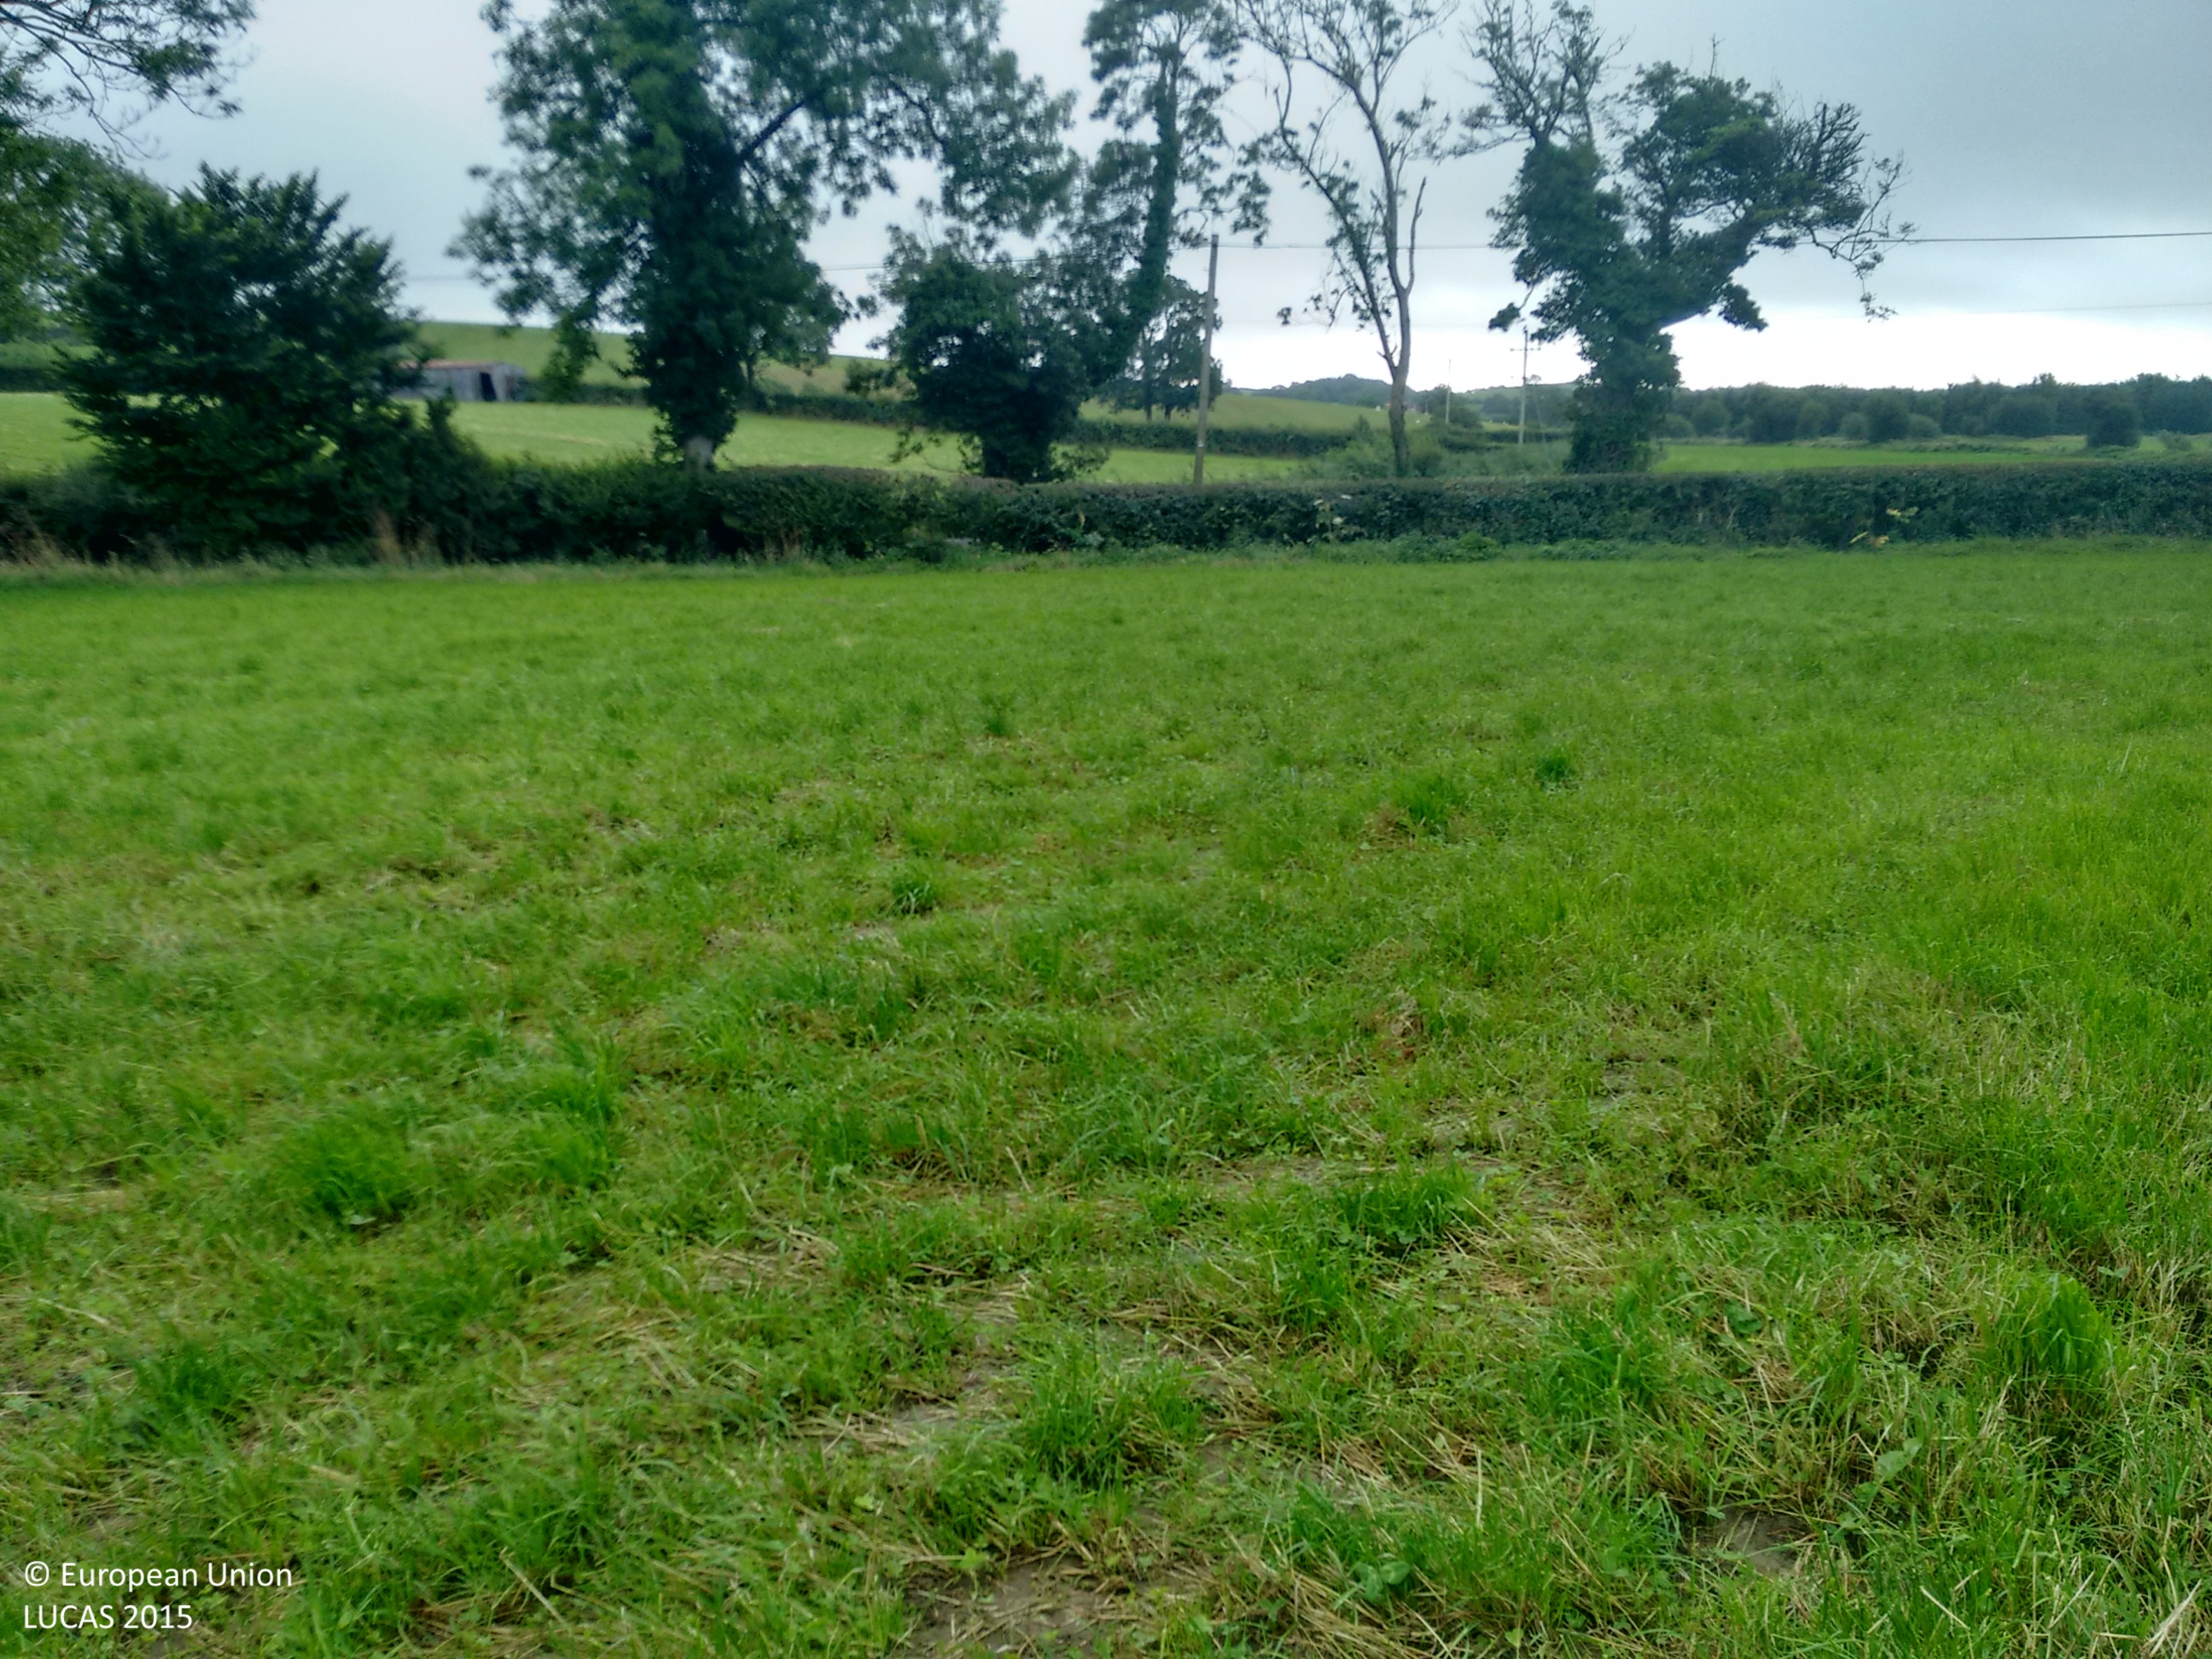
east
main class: Grassland
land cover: Grassland without tree/shrub cover
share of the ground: > 75 %
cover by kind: herbaceous plants 100 %
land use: Agriculture (excluding fallow land and kitchen gardens)
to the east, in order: Grassland without tree/shrub cover; Managed hedges; Grass margins; Paved roads, cycling and walking lanes; Grass margins; Managed hedges; Electric lines; Fences; Grassland without tree/shrub cover; Managed hedges; Fences; Grassland without tree/shrub cover; Shruby margins; Rivers and streams; Abandoned hedges; Grassland without tree/shrub cover
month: August
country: GB
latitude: 54.3571
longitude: -5.7845
